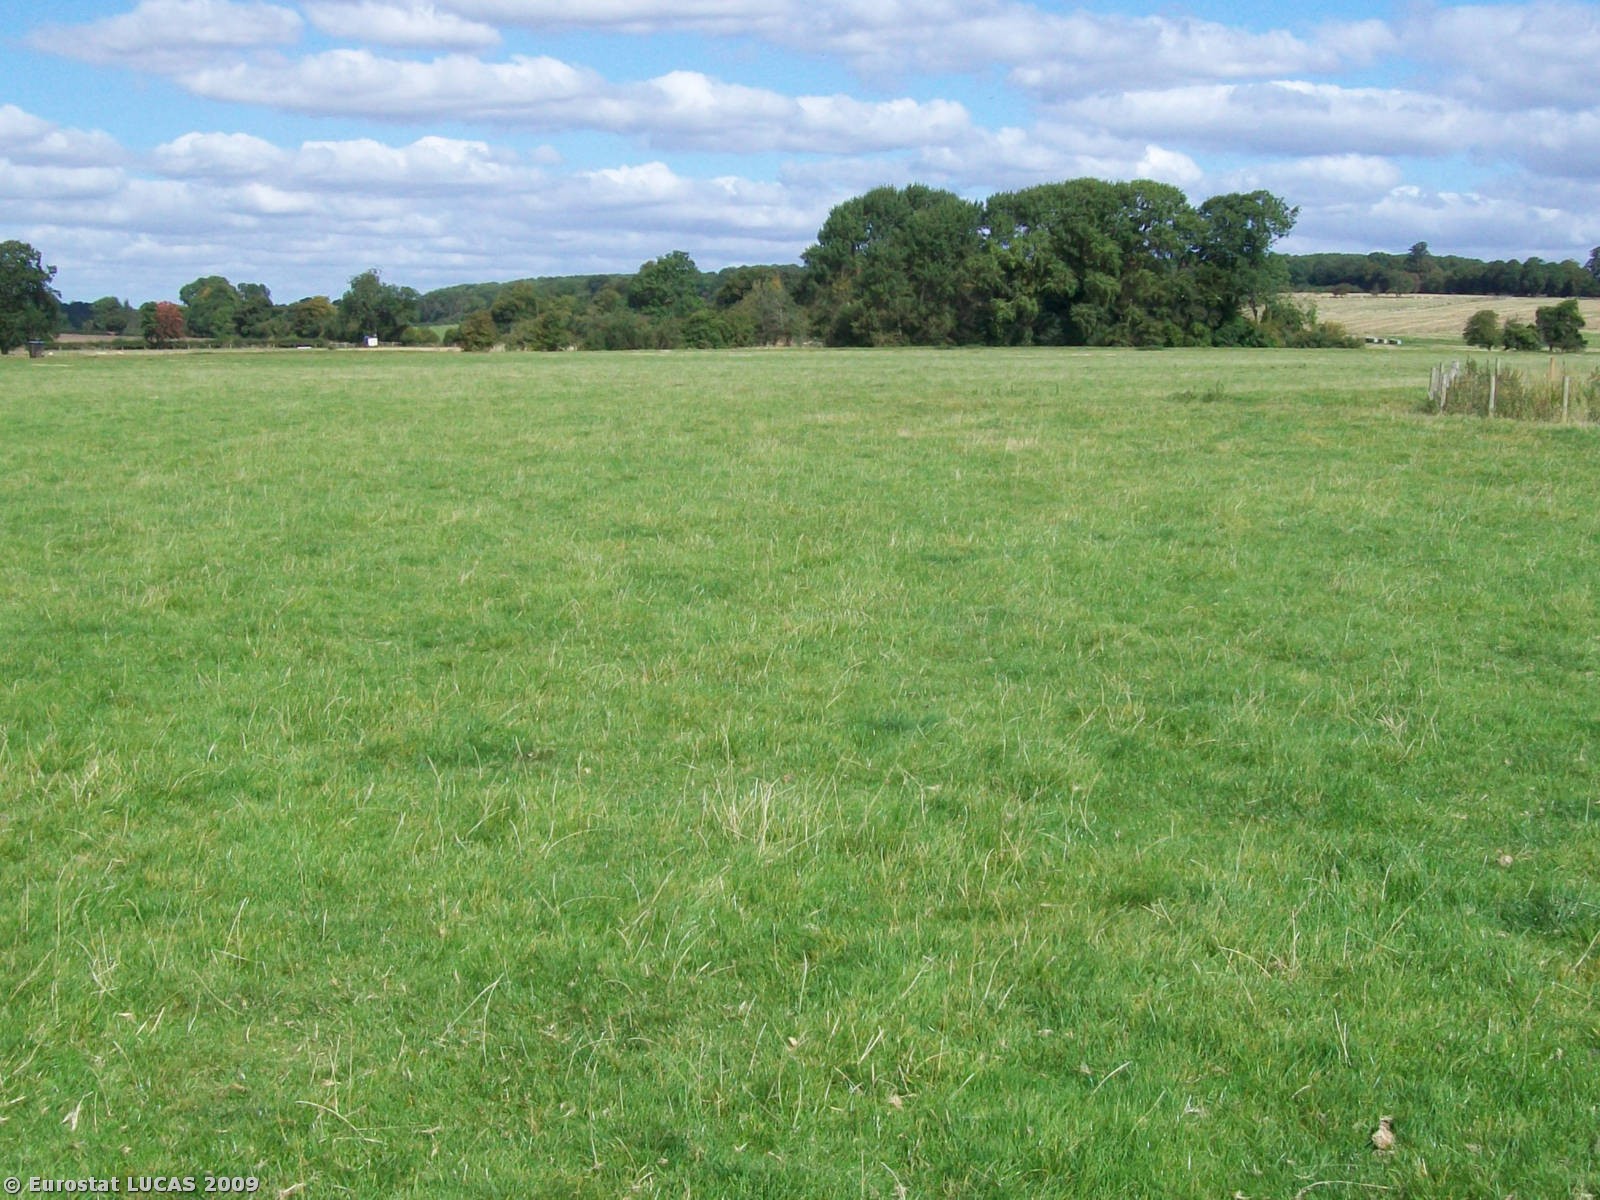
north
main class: Grassland
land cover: Grassland without tree/shrub cover
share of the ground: > 75 %
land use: Agriculture (excluding fallow land and kitchen gardens)
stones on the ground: < 10 %
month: September
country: GB
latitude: 52.1256
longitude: -0.9255
